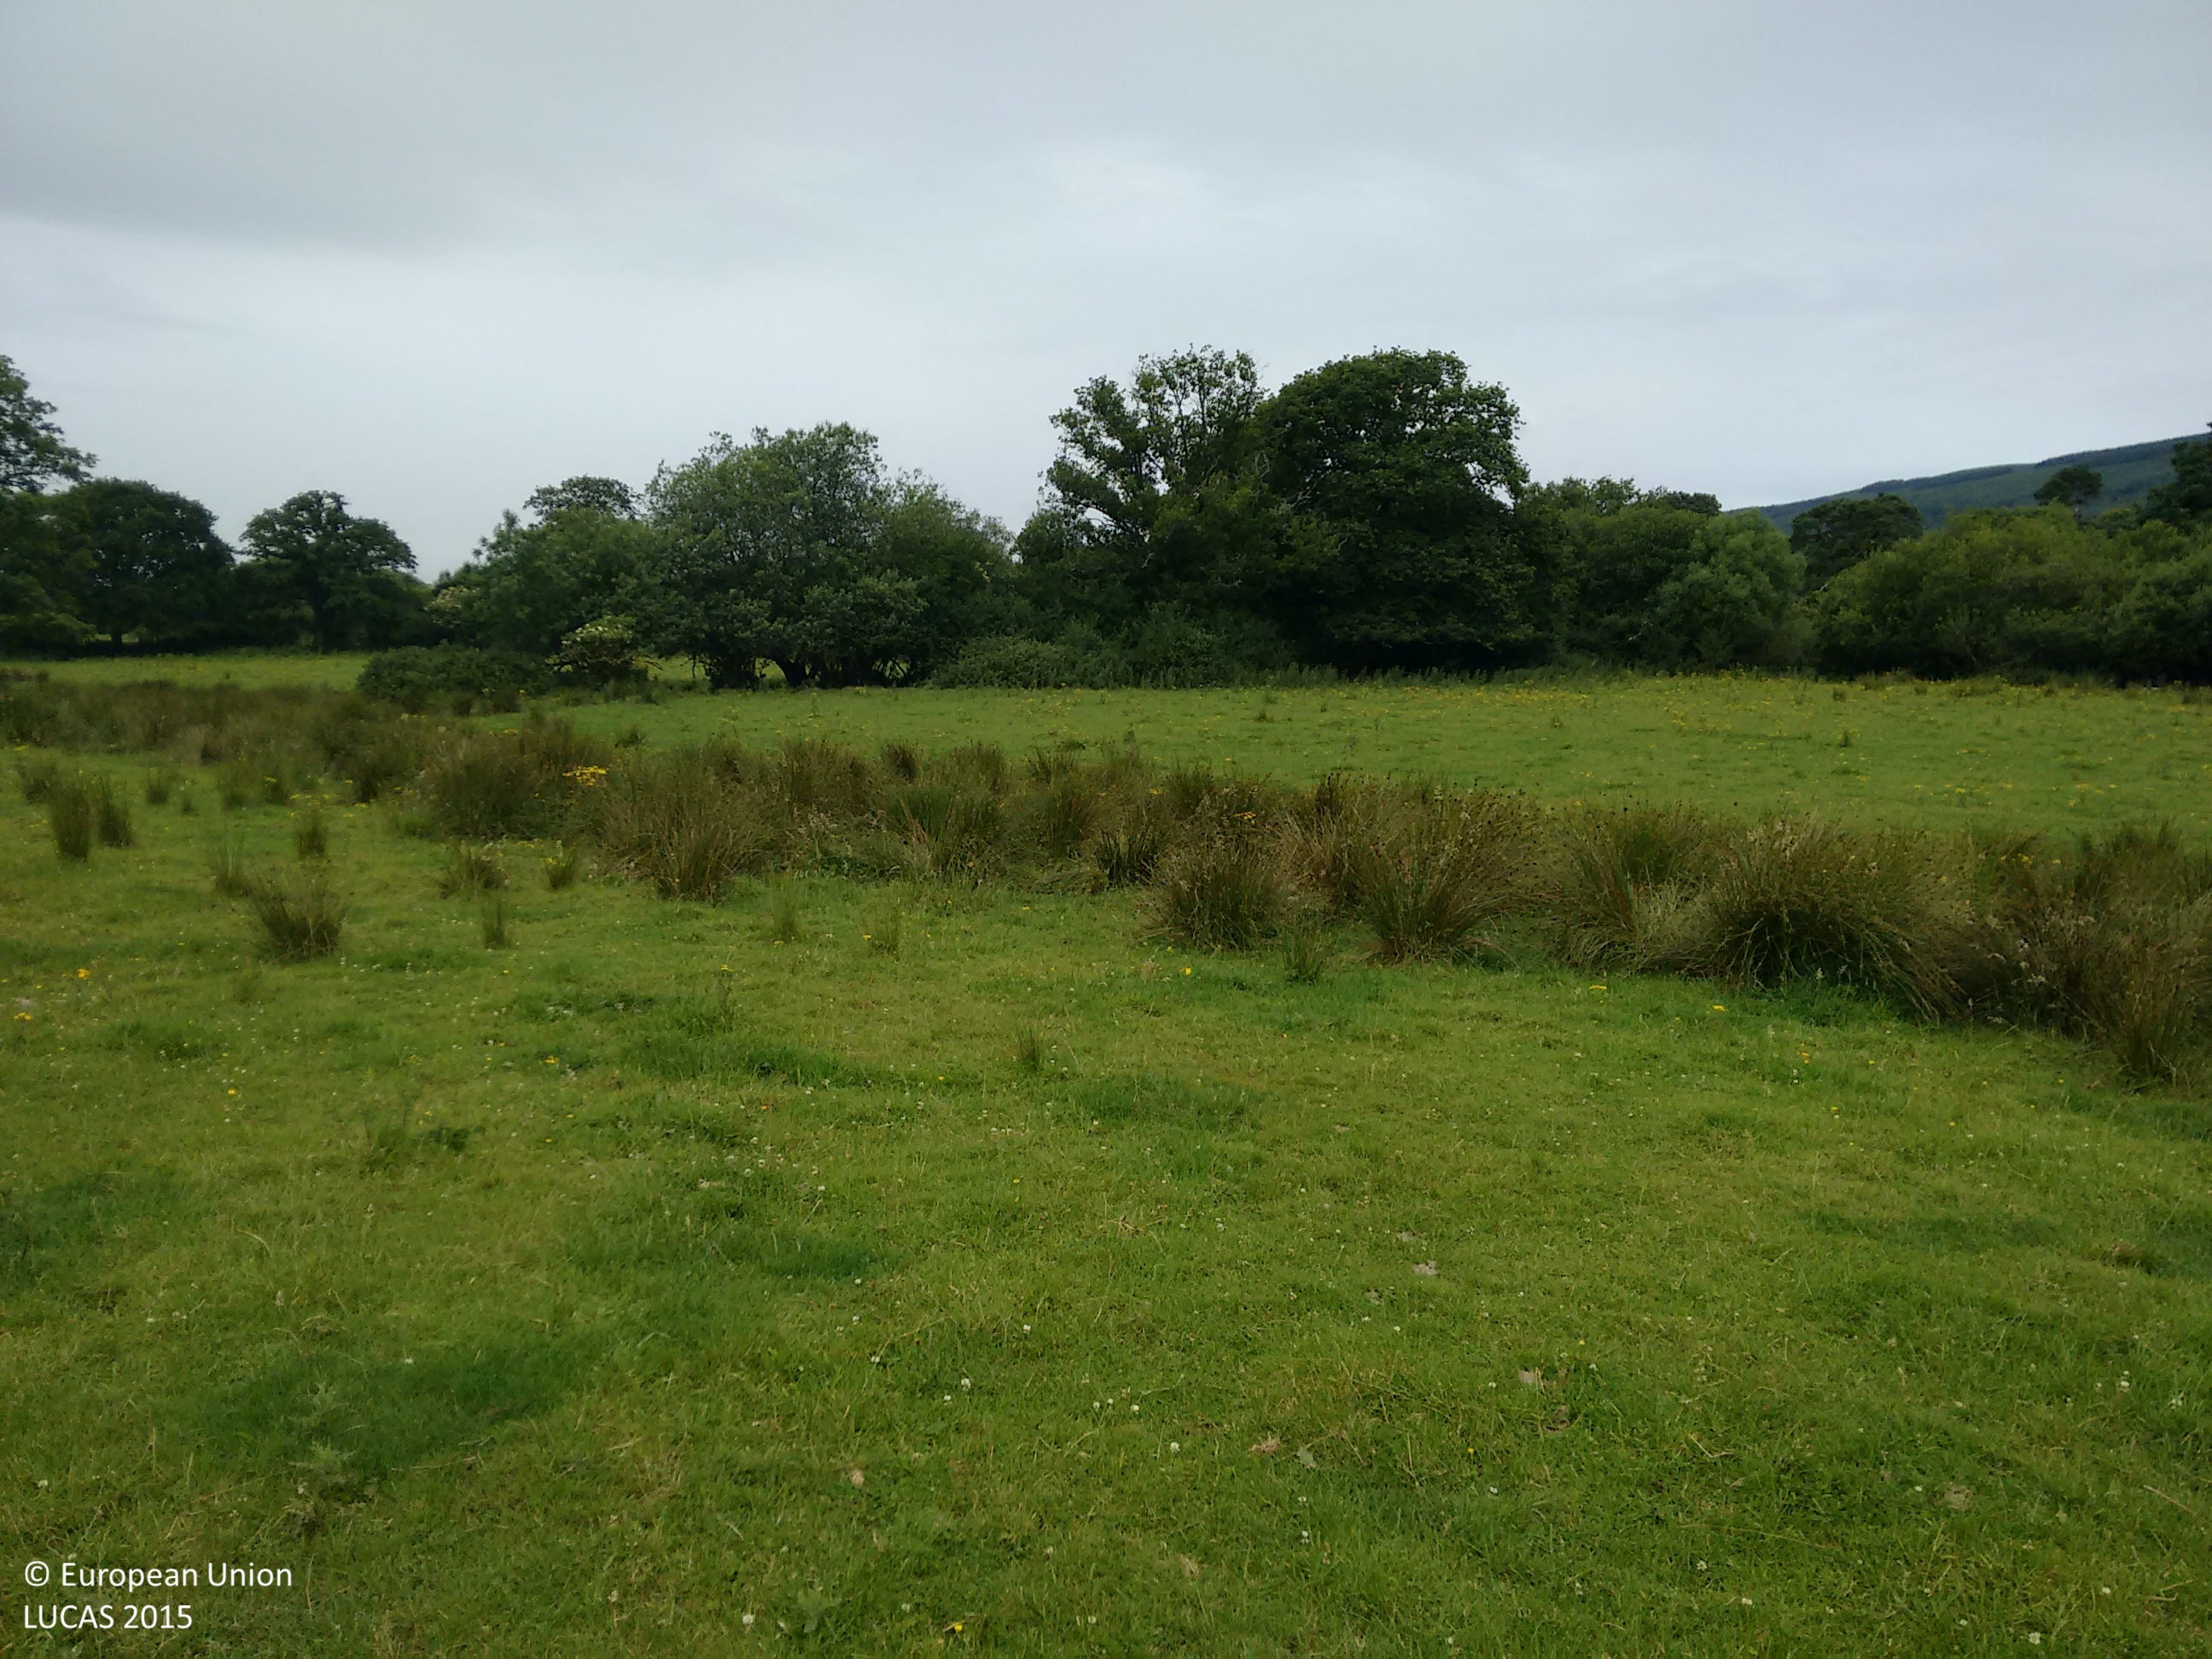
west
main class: Grassland
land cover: Grassland without tree/shrub cover
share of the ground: > 75 %
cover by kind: herbaceous plants 100 %
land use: Agriculture (excluding fallow land and kitchen gardens)
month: July
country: IE
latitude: 52.4123
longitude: -8.1922
